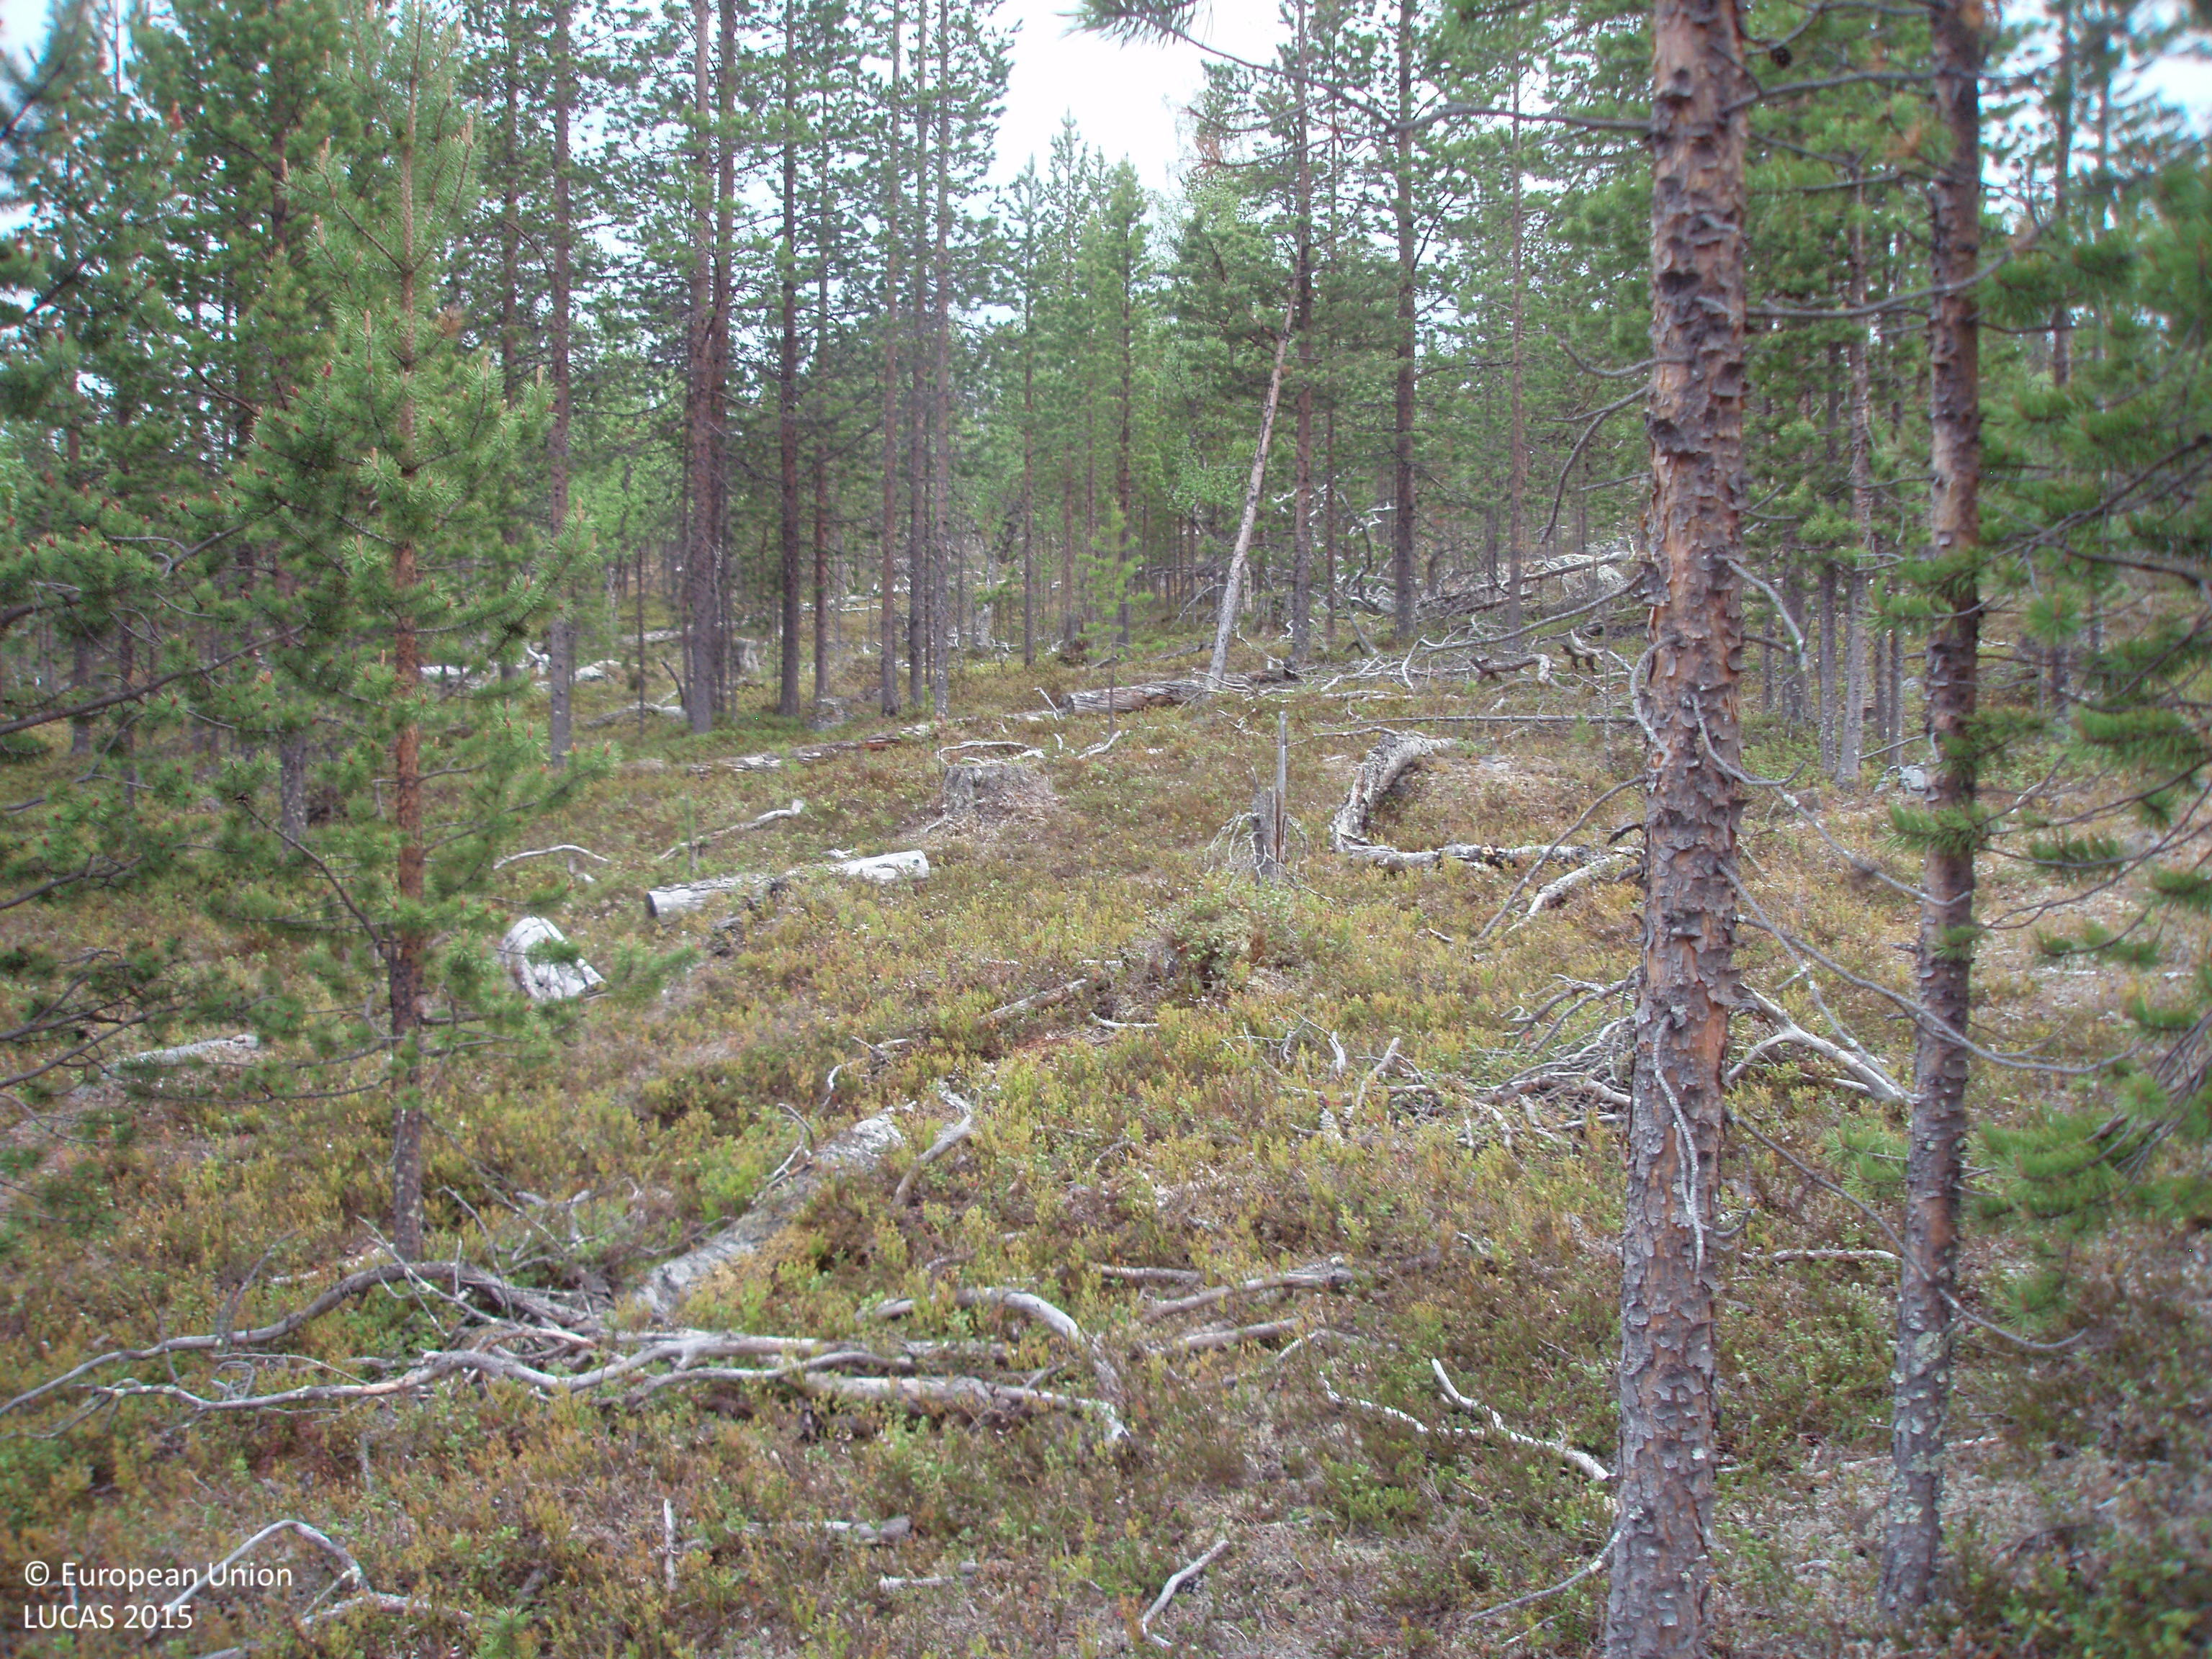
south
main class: Woodland
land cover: Pine dominated coniferous woodland
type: boreal forest
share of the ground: 50 - 75 %
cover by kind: coniferous forest trees 45 %, shrubs 30 %, broadleaved forest trees 15 %, lichens and mosses 10 %
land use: Forestry
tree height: > 5 m
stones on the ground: > 50 %
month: June
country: FI
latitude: 68.8315
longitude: 27.2635
